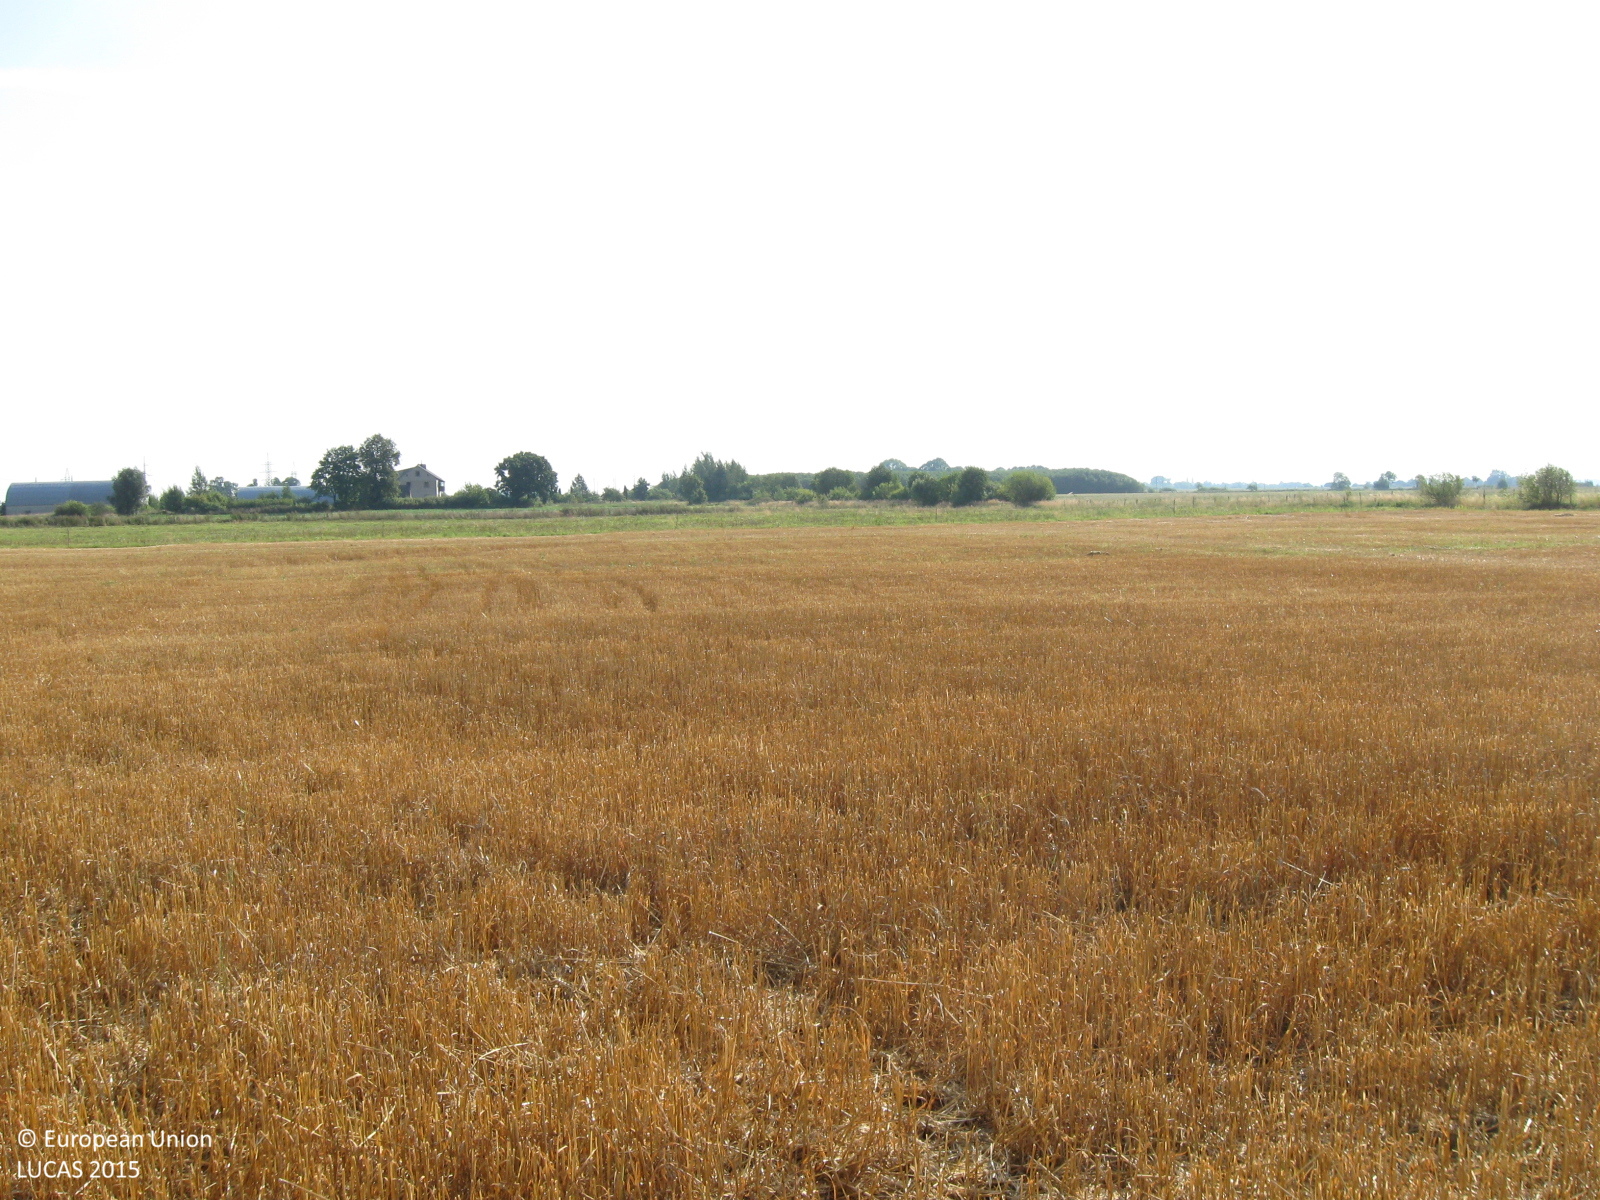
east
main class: Cropland
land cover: Common wheat
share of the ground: > 75 %
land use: Agriculture (excluding fallow land and kitchen gardens)
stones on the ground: < 10 %
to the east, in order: Common wheat; Grass margins; Fences; Grassland without tree/shrub cover; Fences; Grass margins; Tracks; Shruby margins; Broadleaved woodland; Fences; Tracks
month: August
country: LT
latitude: 55.1016
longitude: 22.8413
